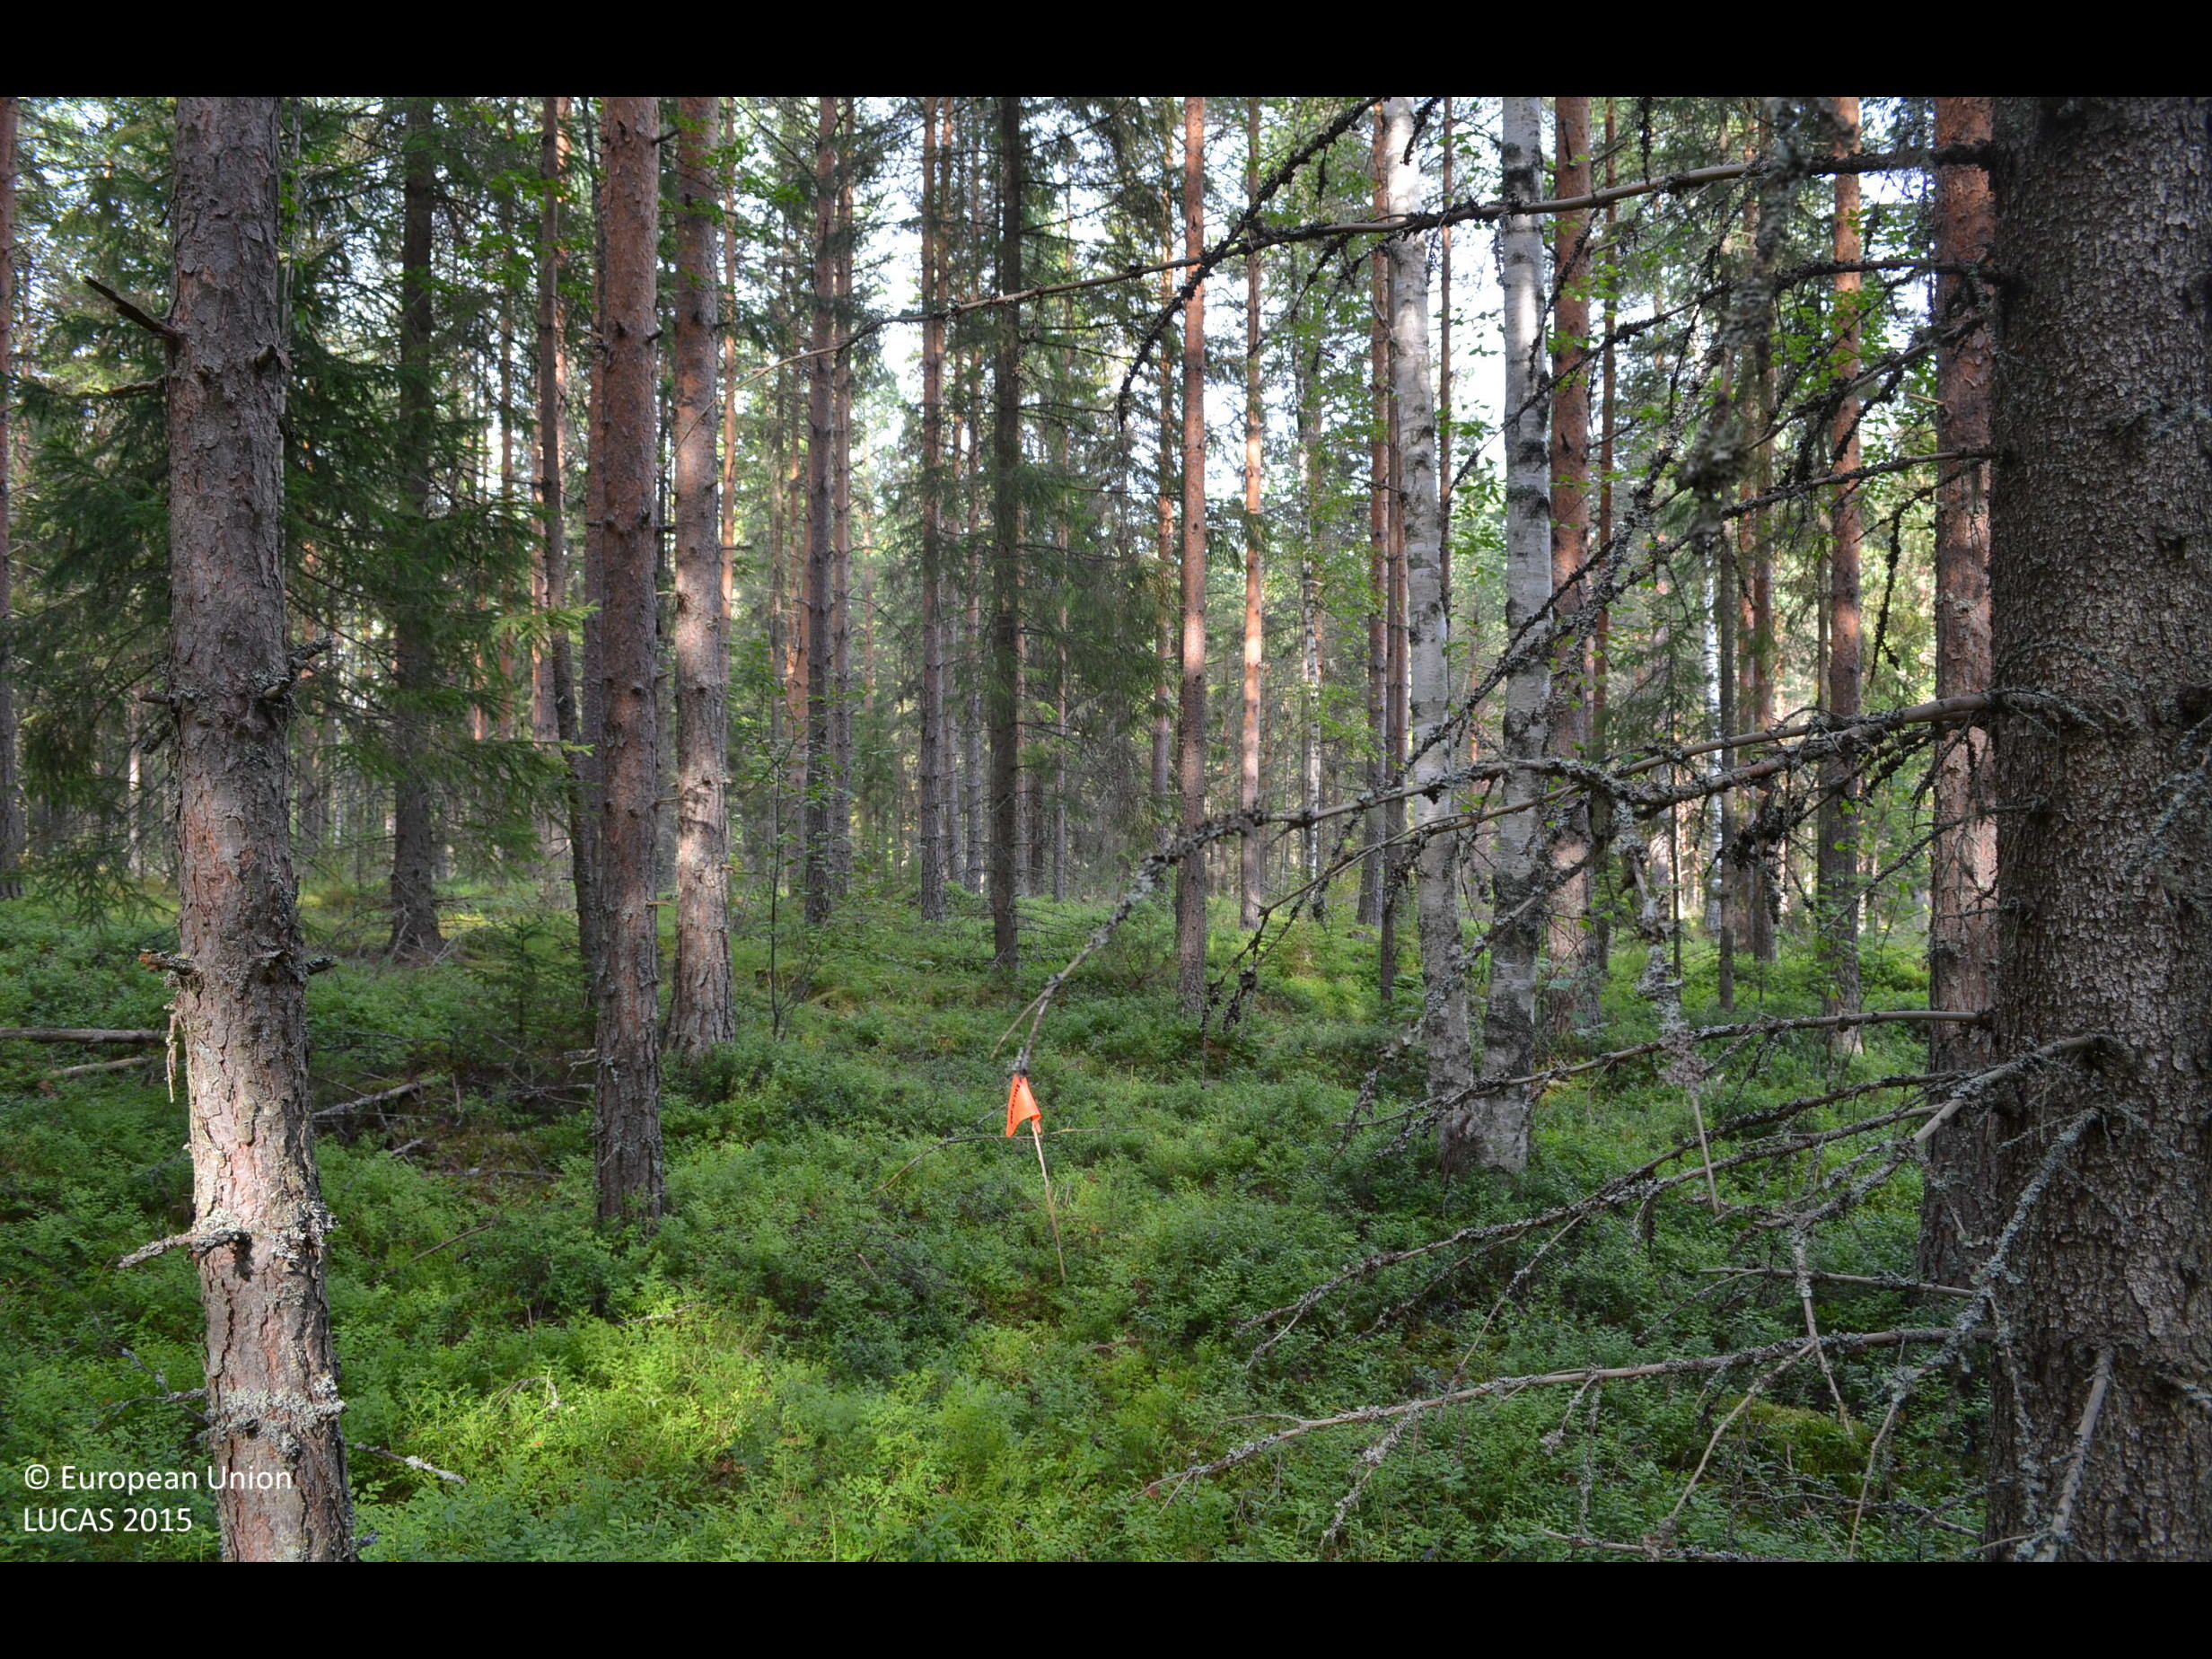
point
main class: Woodland
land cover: Other coniferous woodland
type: boreal forest
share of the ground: > 75 %
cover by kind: coniferous forest trees 70 %, shrubs 25 %, broadleaved forest trees 5 %
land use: Forestry
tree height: > 5 m
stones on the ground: < 10 %
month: July
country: FI
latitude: 61.9970
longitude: 24.3140
